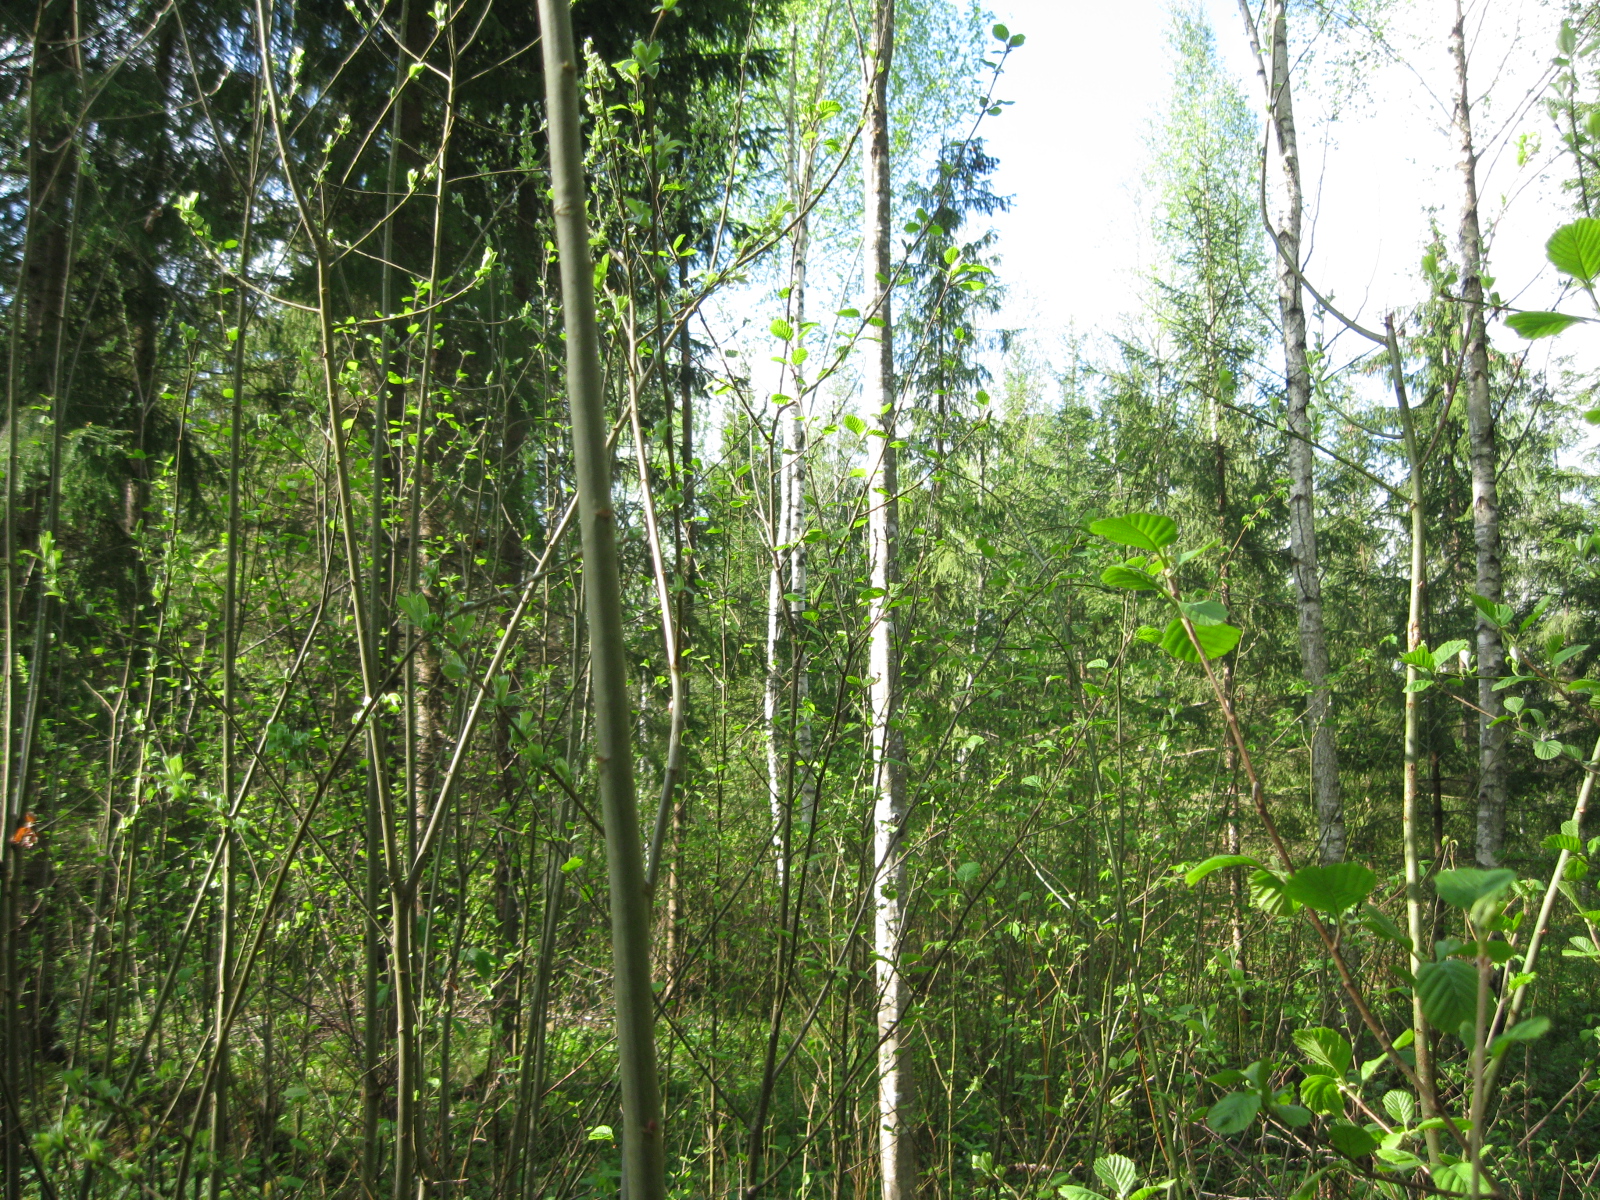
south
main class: Woodland
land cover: Spruce dominated mixed woodland
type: hemiboreal forest and nemoral coniferous forest and mixed broadleaved-coniferous forest
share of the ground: > 75 %
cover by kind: coniferous forest trees 60 %, broadleaved forest trees 25 %, herbaceous plants 15 %
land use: Forestry
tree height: > 5 m
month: May
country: LT
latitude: 56.2899
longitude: 24.9880
